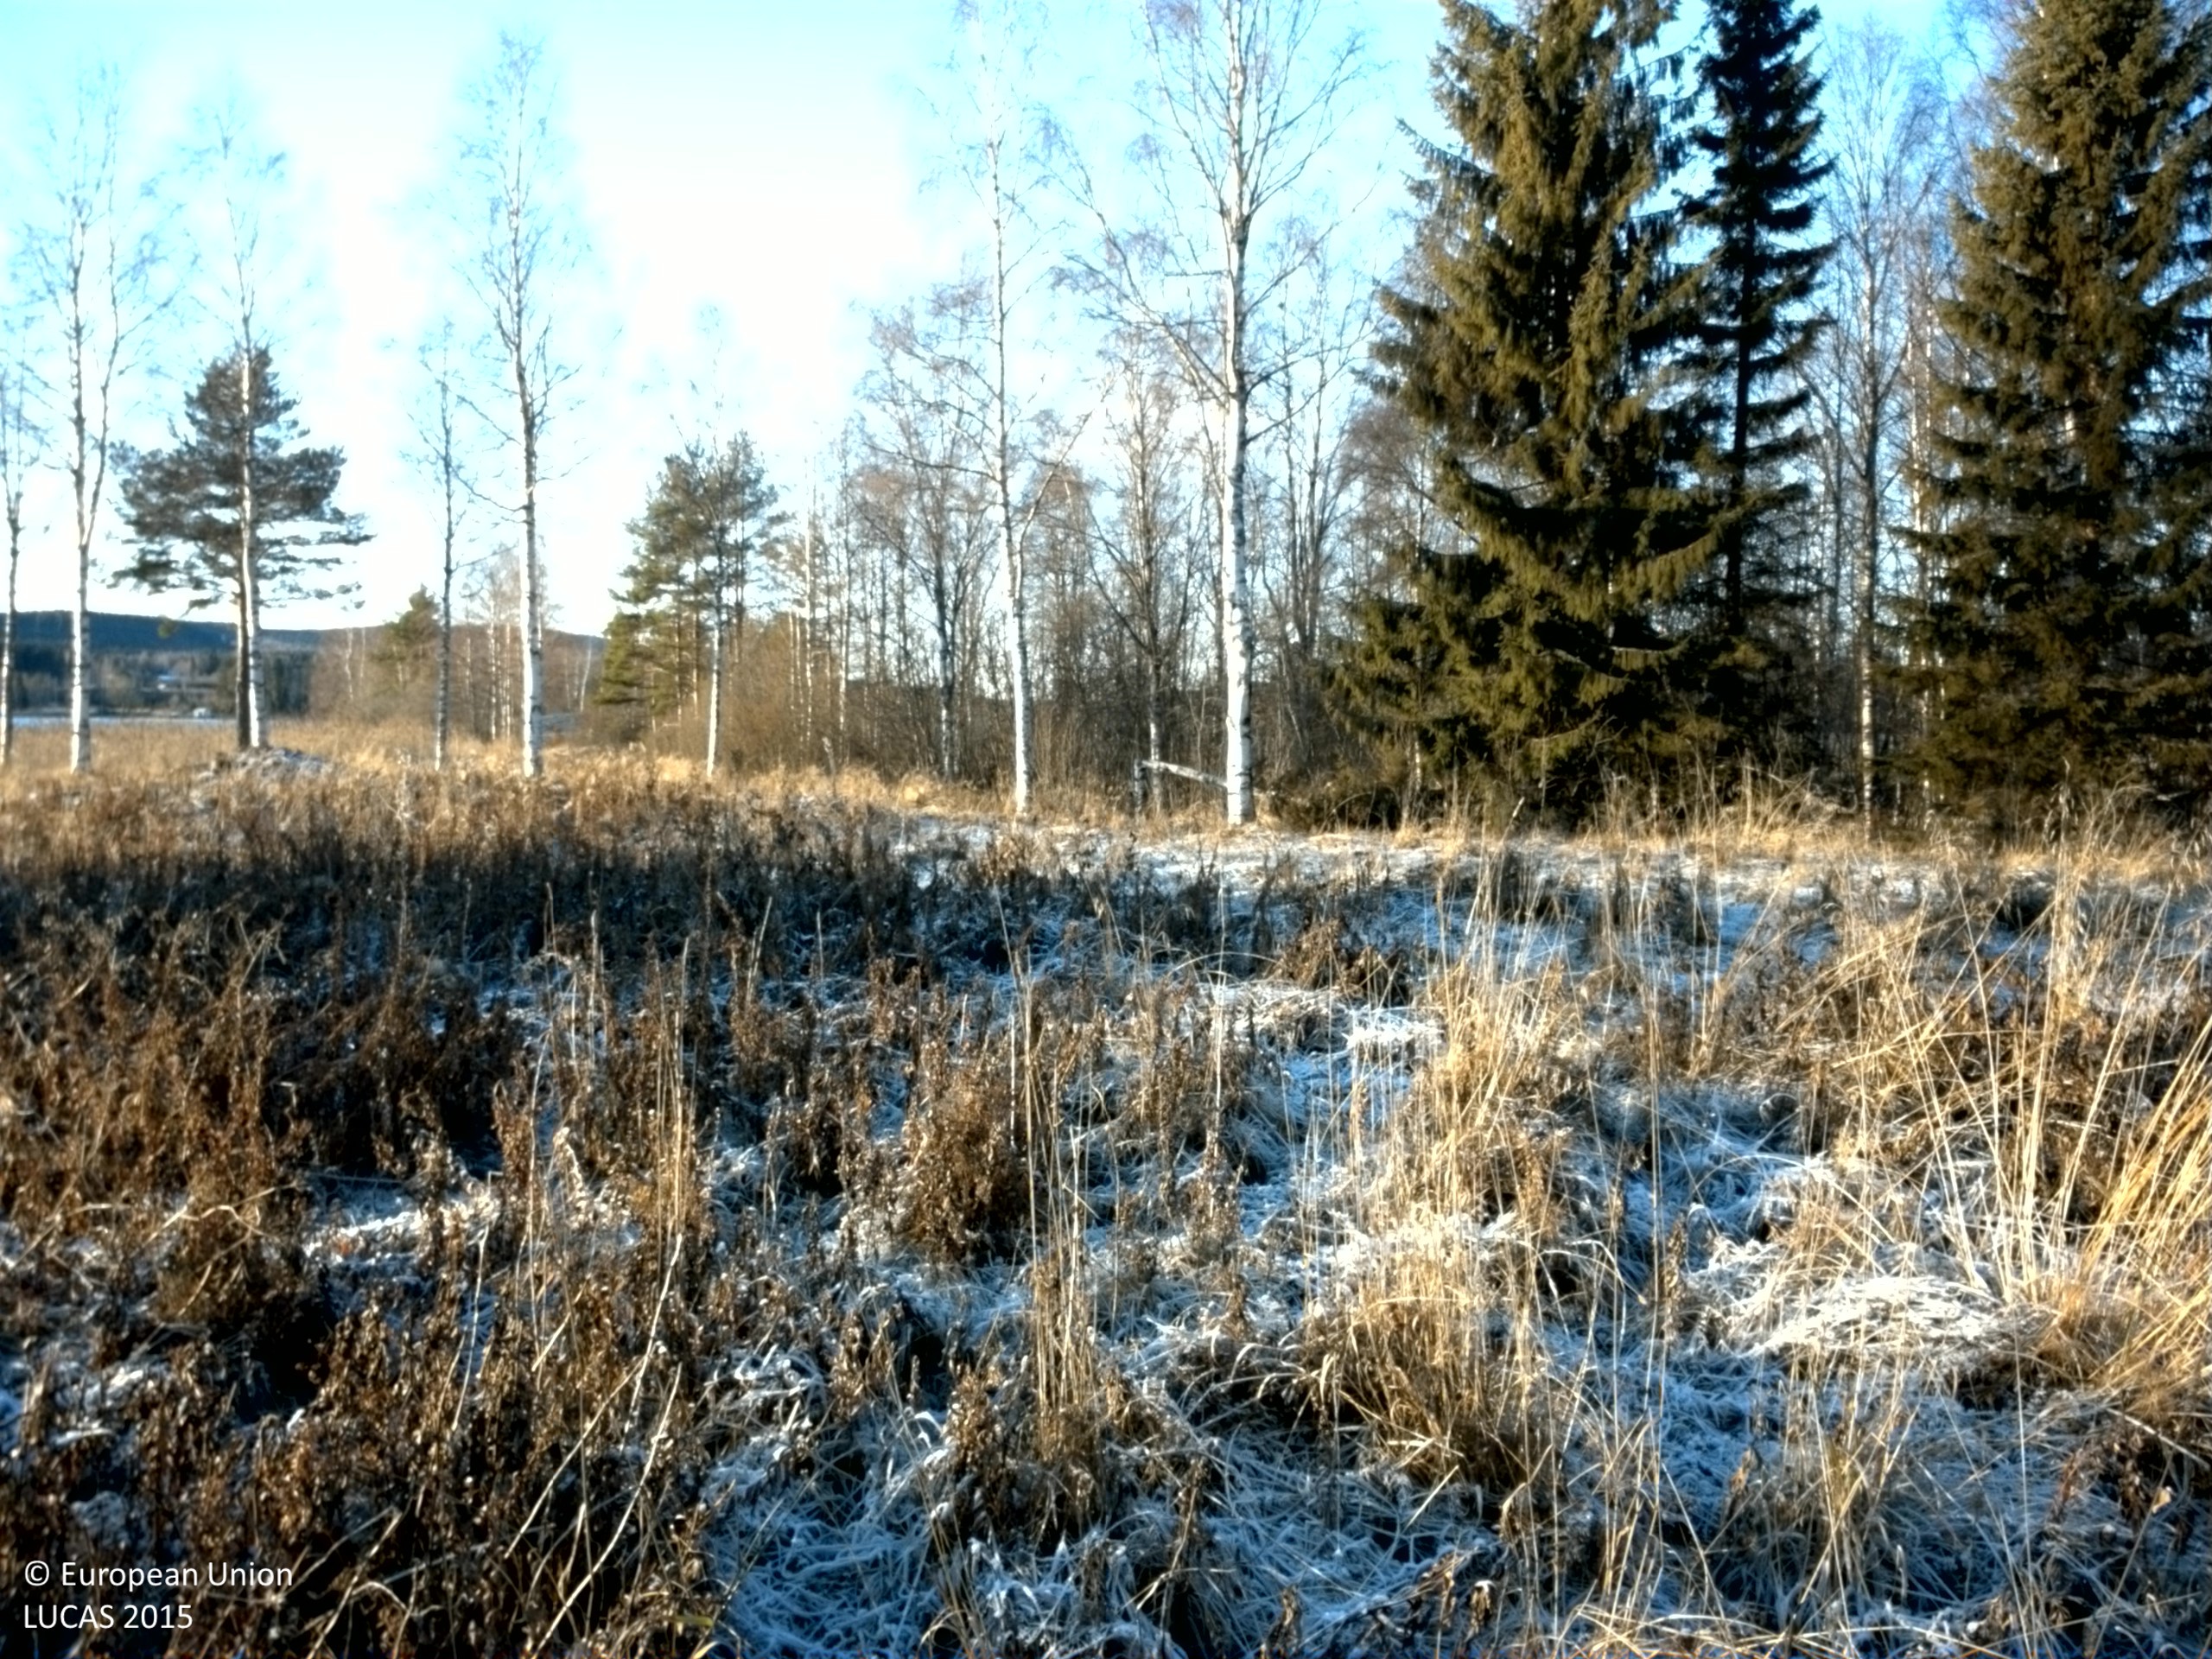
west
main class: Grassland
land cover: Grassland with sparse tree/shrub cover
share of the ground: > 75 %
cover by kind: herbaceous plants 95 %, broadleaved forest trees 5 %
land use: Amenities, museums, leisure
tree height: > 5 m
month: November
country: SE
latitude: 61.8650
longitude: 16.3125
